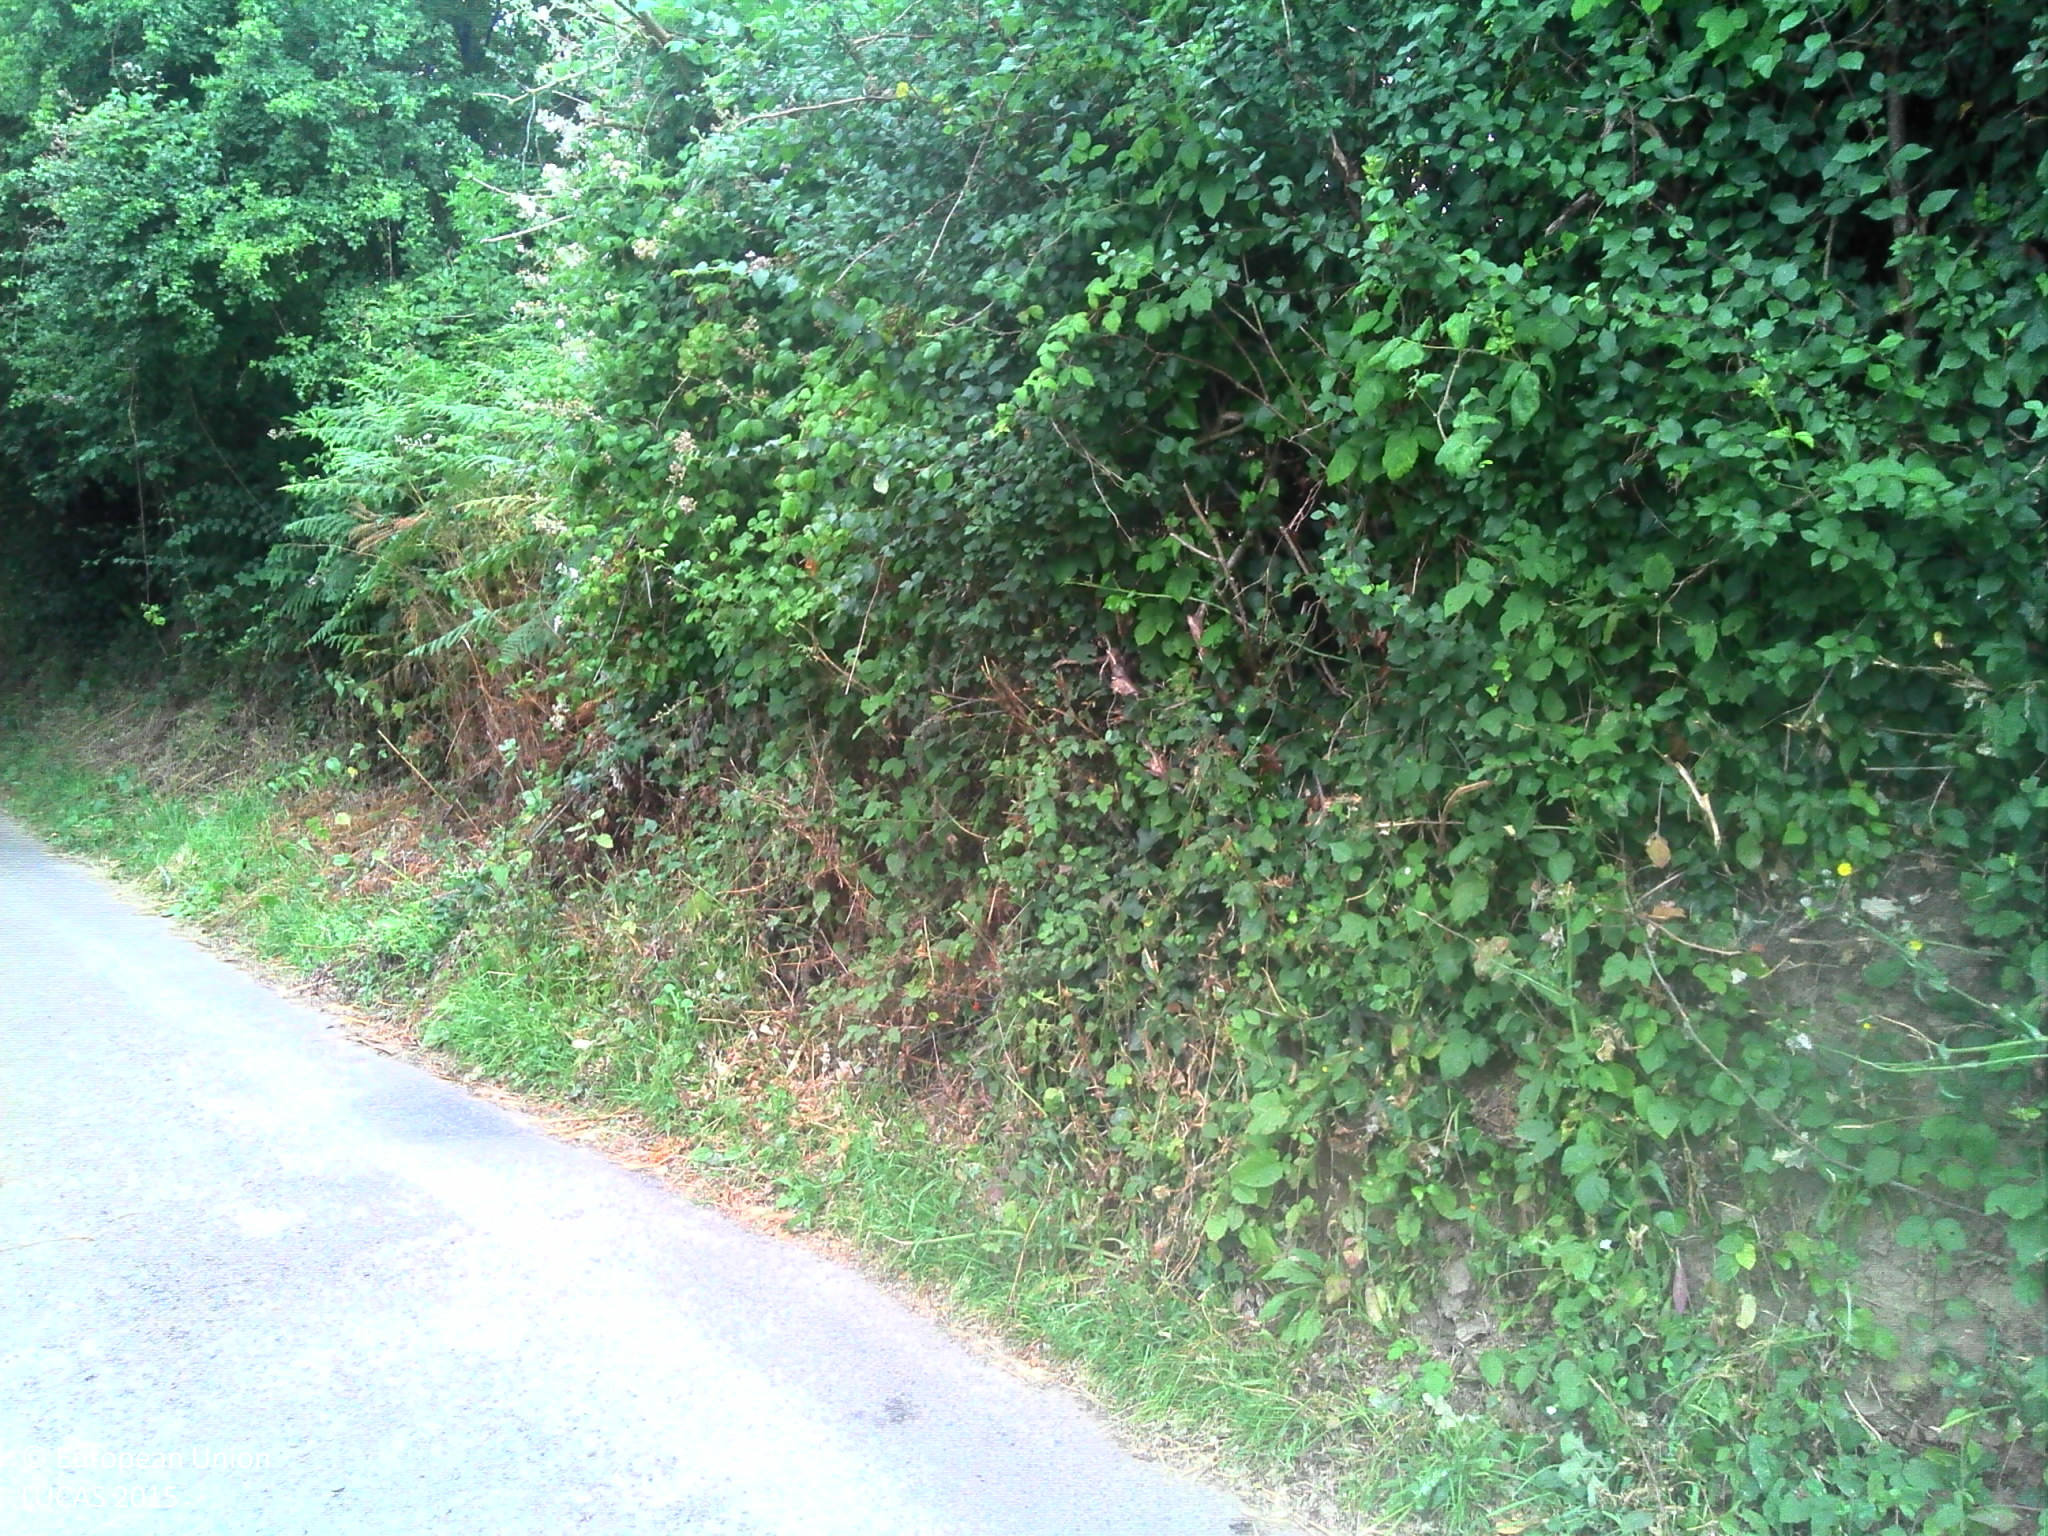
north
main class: Grassland
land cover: Grassland with sparse tree/shrub cover
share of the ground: > 75 %
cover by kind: herbaceous plants 95 %, broadleaved forest trees 5 %
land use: Residential
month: July
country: FR
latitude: 48.8513
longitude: -1.5372
